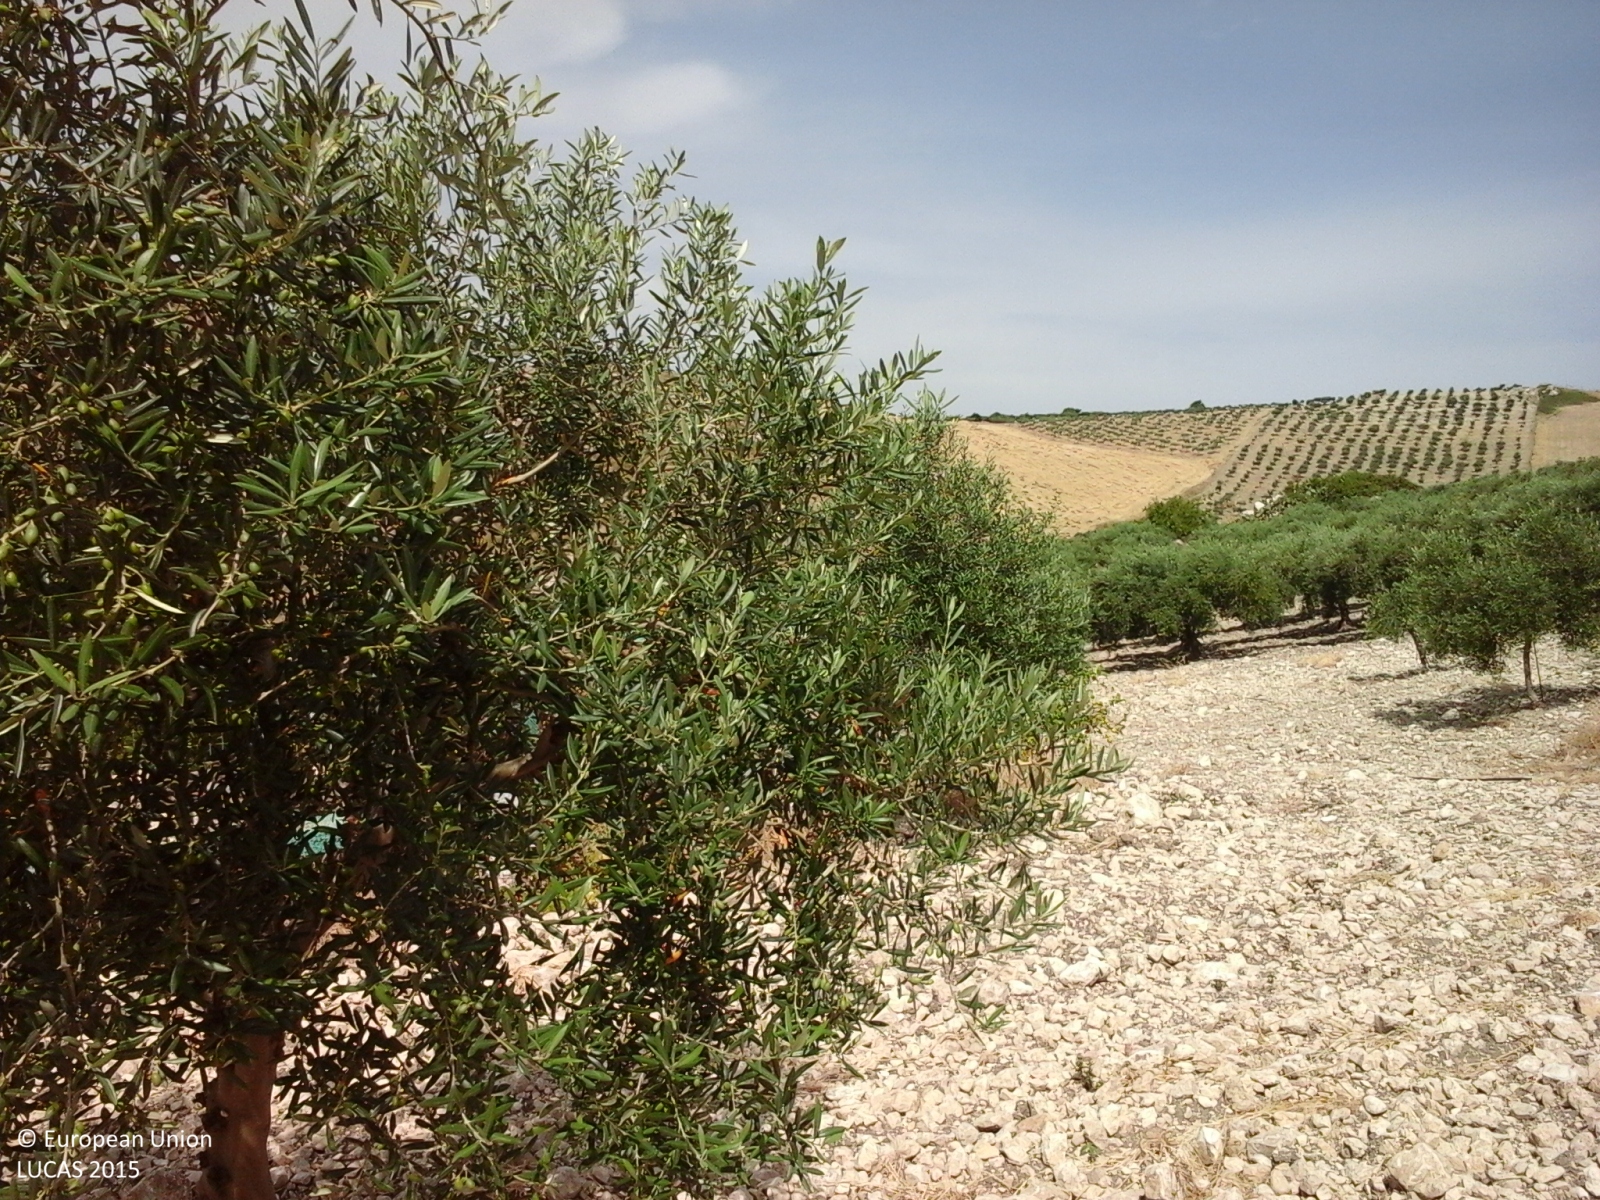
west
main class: Cropland
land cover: Olive groves
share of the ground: 25 - 50 %
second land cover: Other bare soil
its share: > 75 %
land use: Agriculture (excluding fallow land and kitchen gardens)
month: June
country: IT
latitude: 37.5687
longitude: 13.1349
